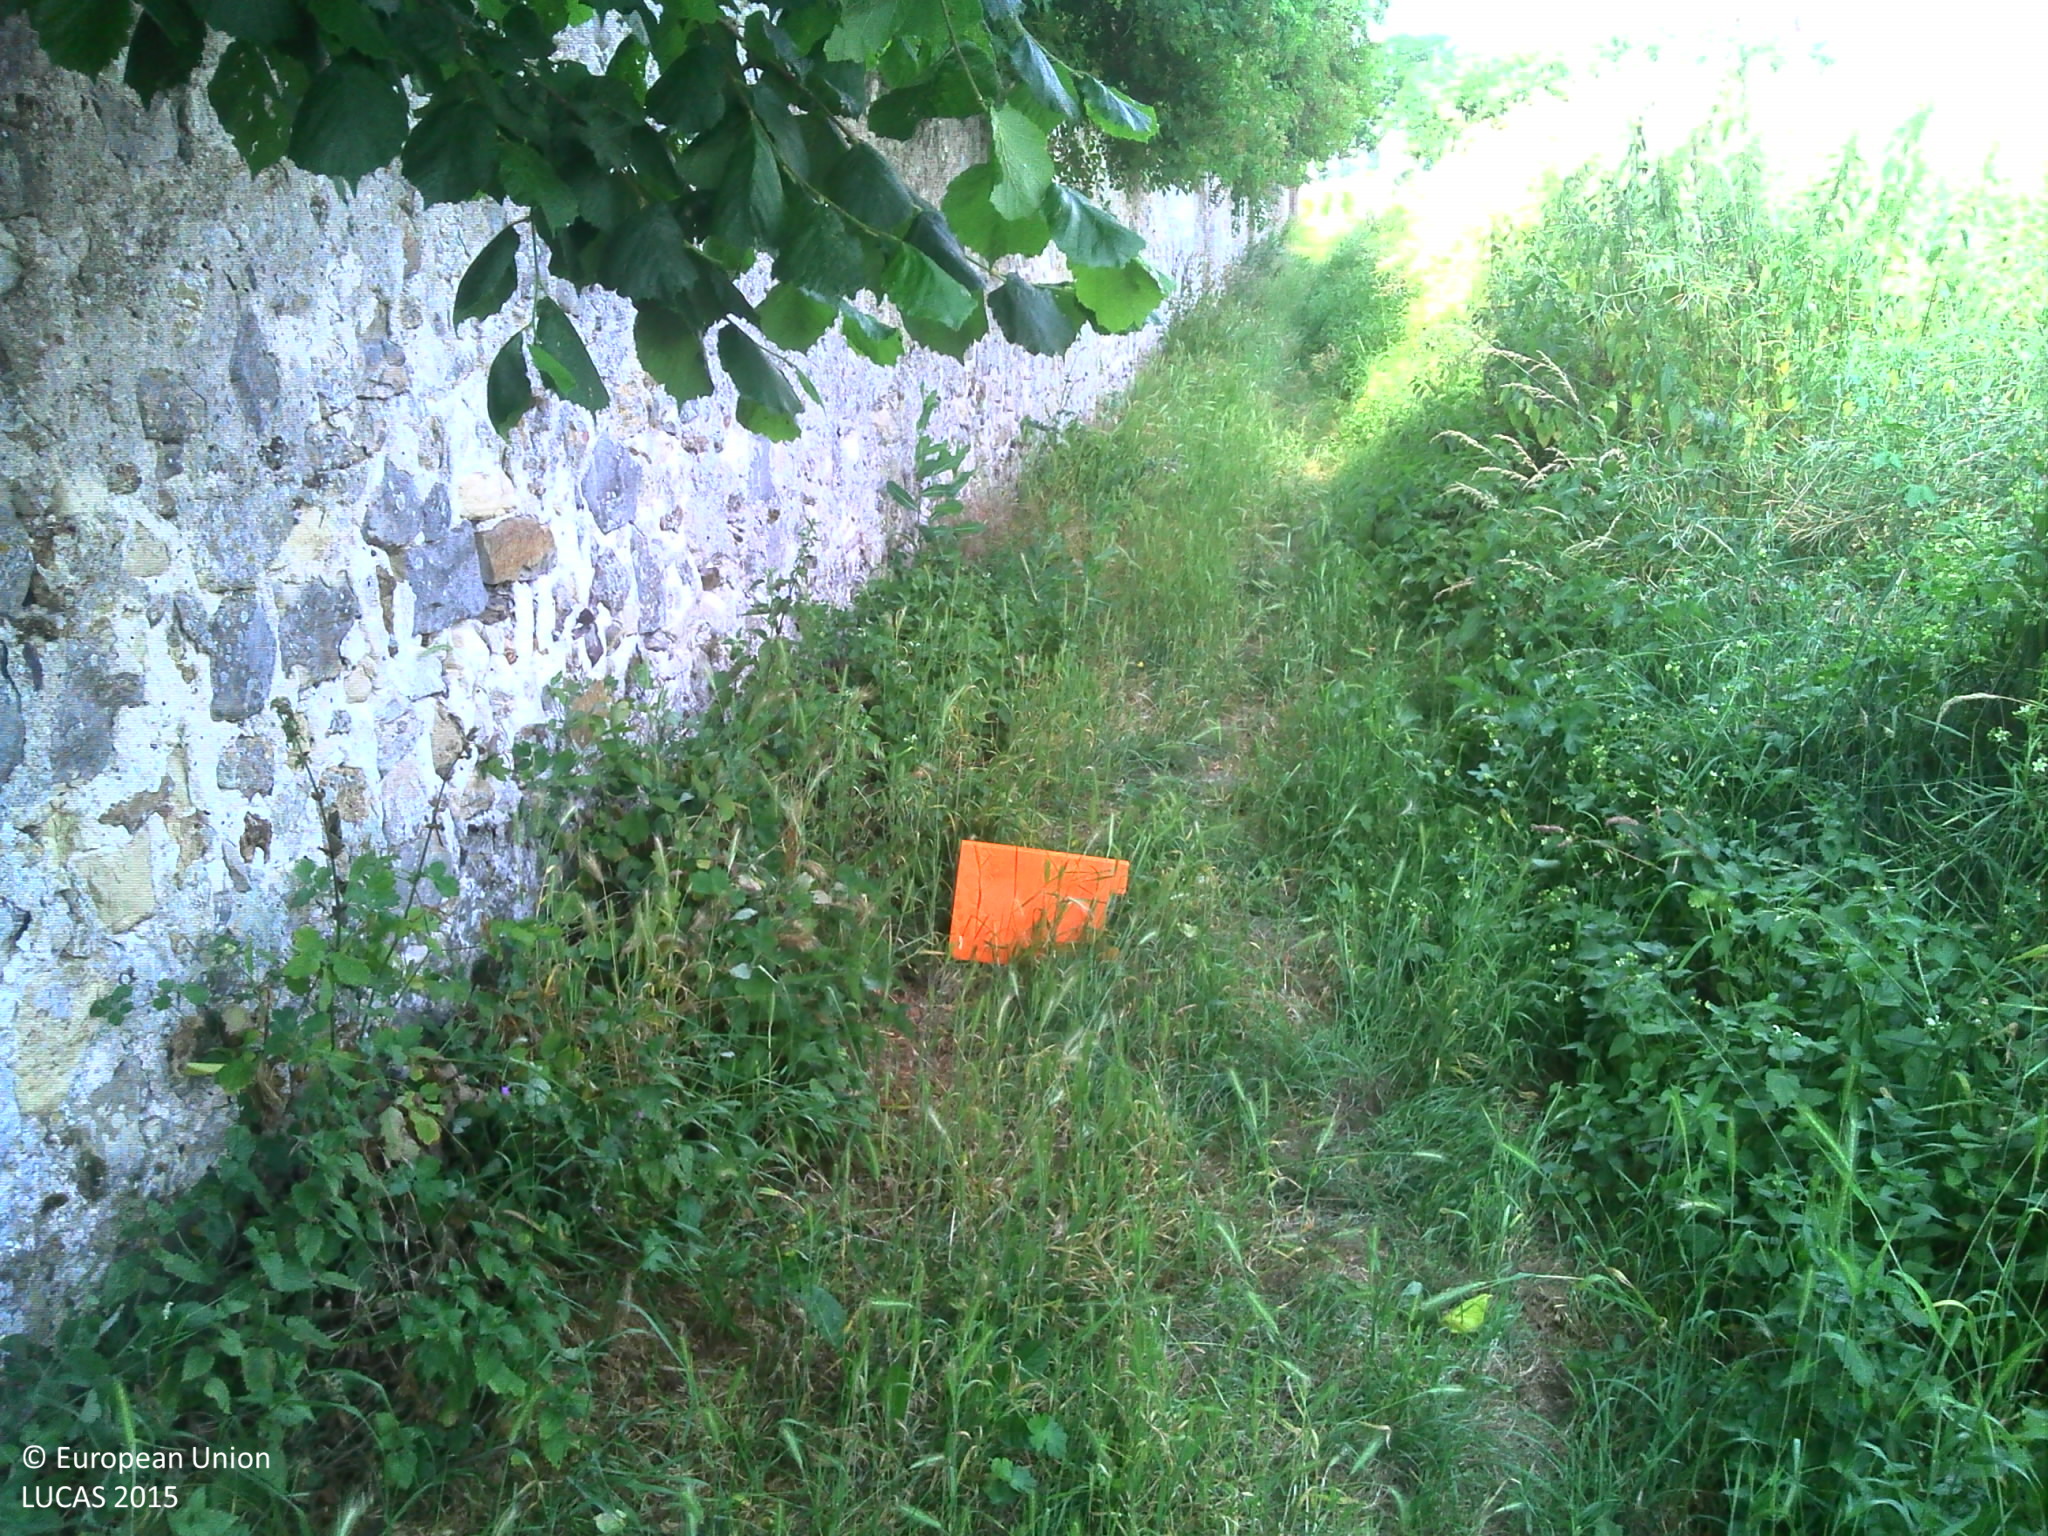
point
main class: Cropland
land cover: Rape and turnip rape
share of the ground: > 75 %
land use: Agriculture (excluding fallow land and kitchen gardens)
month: July
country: FR
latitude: 49.1220
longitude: 3.3193
